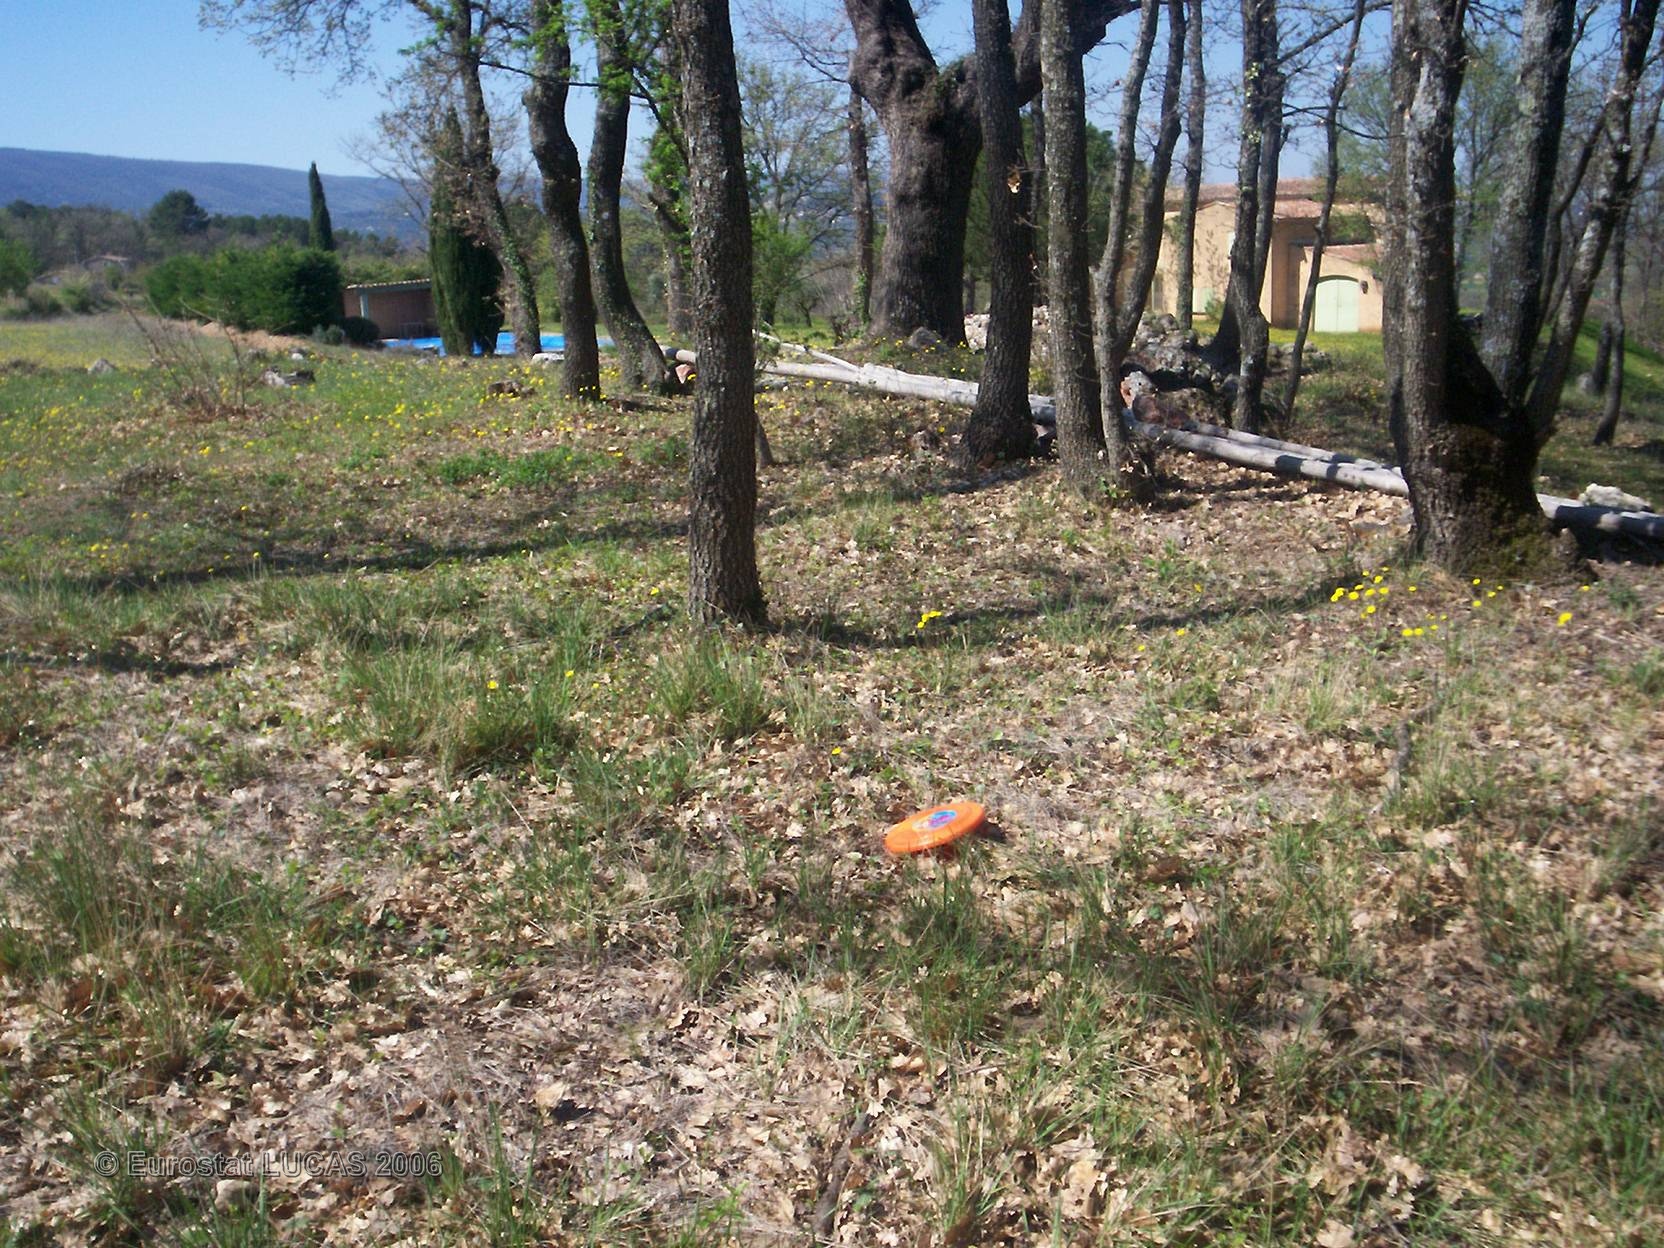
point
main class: Woodland
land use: Forestry
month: April
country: FR
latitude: 43.8475
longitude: 5.3193
